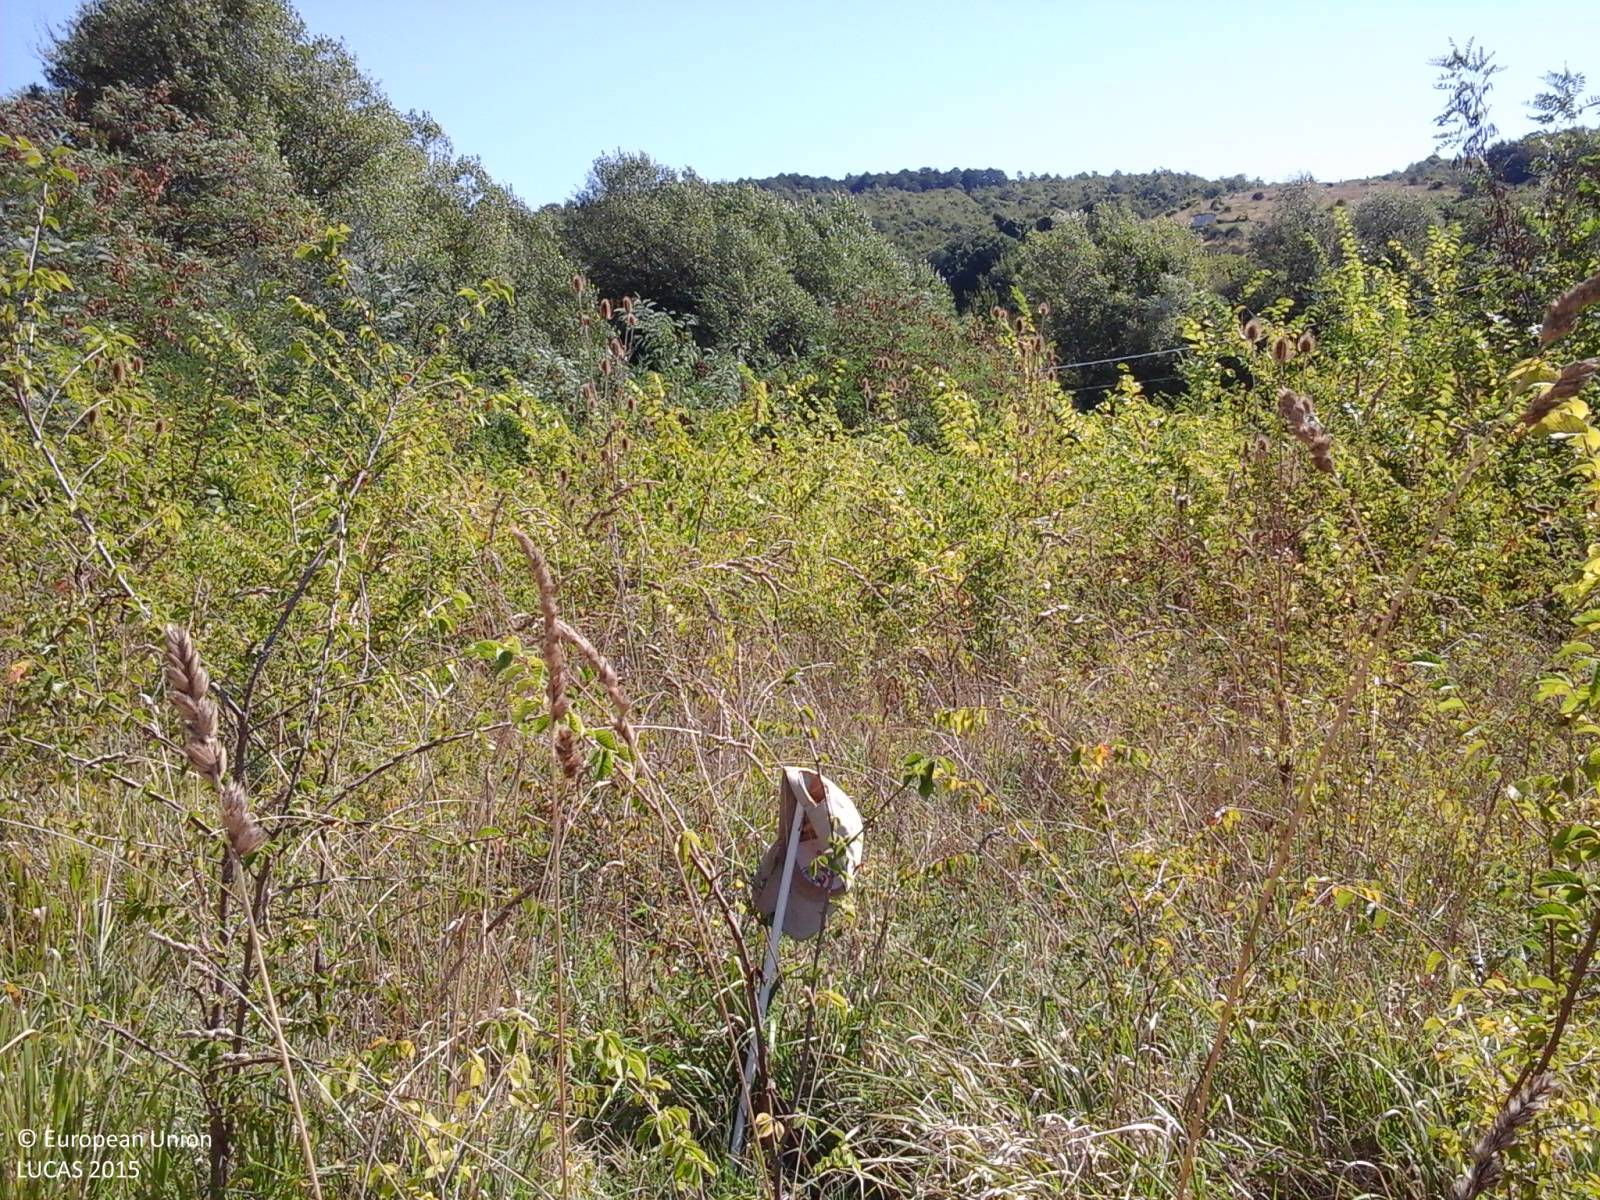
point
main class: Shrubland
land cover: Shrubland with sparse tree cover
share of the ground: 50 - 75 %
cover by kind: shrubs 55 %, herbaceous plants 40 %, broadleaved forest trees 5 %
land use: Abandoned areas
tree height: < 5 m
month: September
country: IT
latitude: 43.1256
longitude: 12.6352
